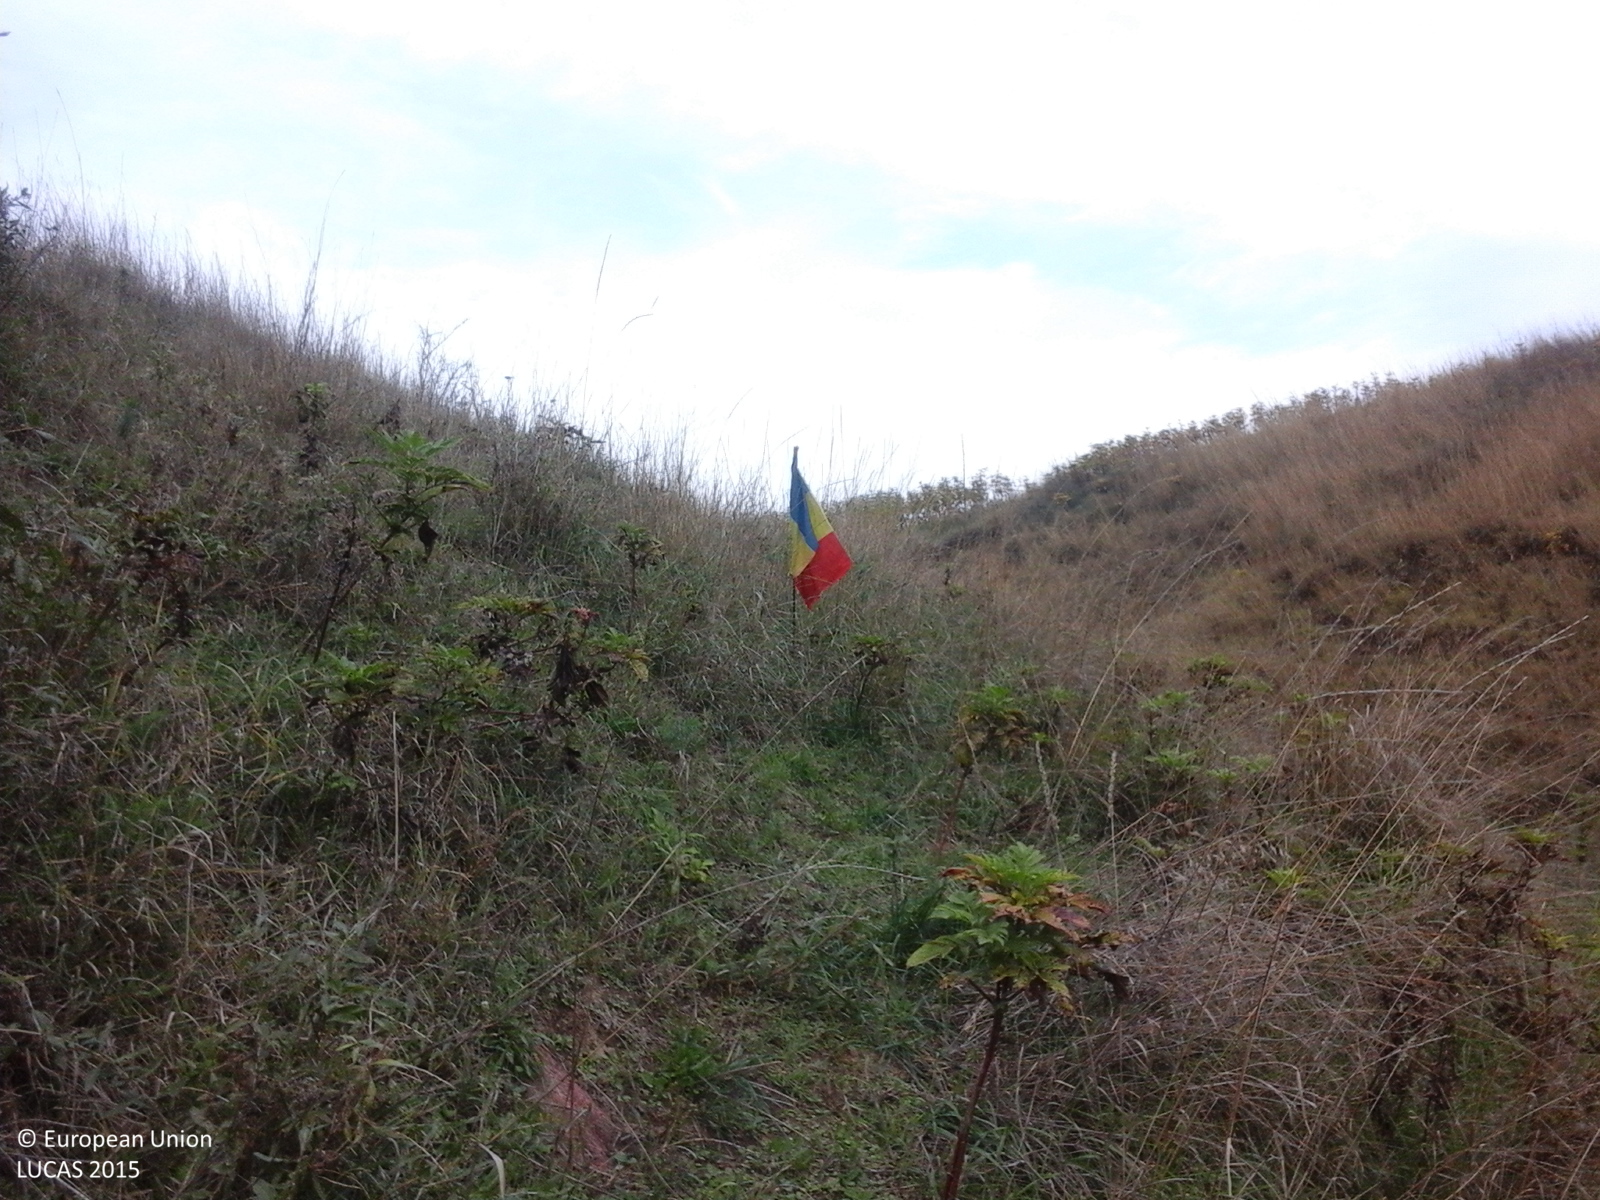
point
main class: Grassland
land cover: Spontaneously vegetated surfaces
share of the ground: > 75 %
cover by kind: herbaceous plants 100 %
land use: Semi-natural and natural areas not in use
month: October
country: RO
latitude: 45.0096
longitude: 26.3448
